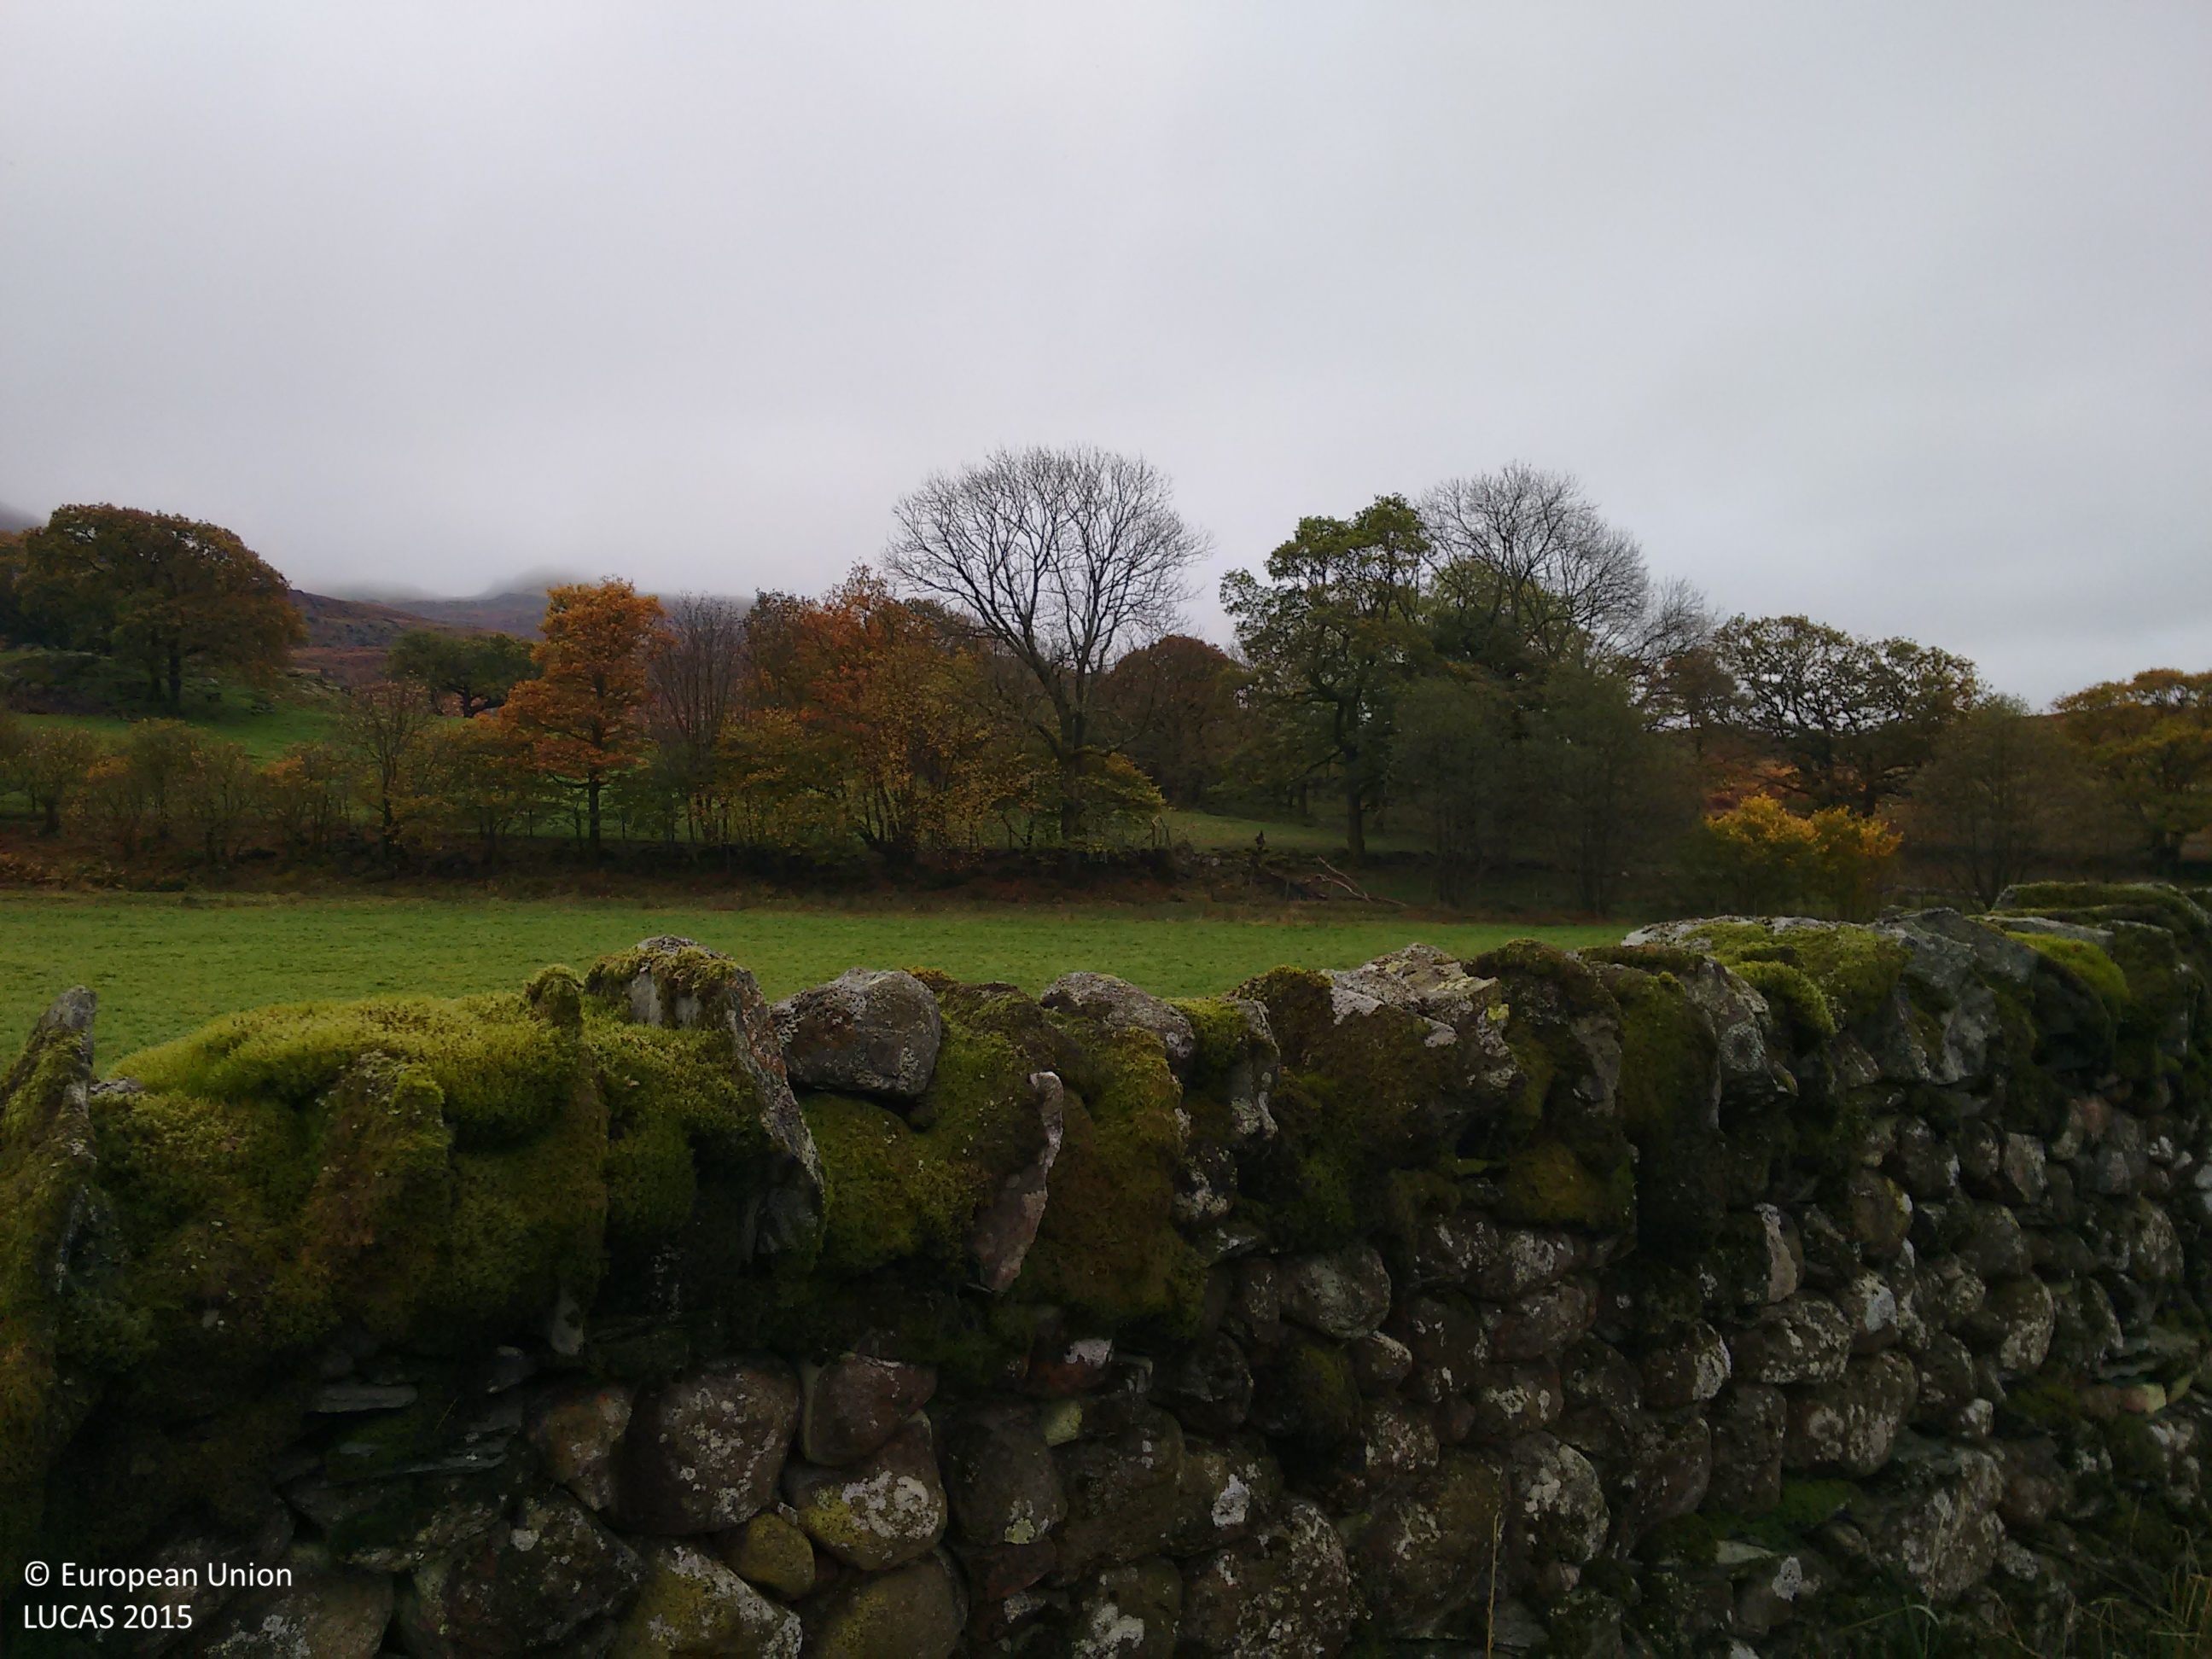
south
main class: Grassland
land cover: Grassland without tree/shrub cover
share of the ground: > 75 %
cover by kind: herbaceous plants 100 %
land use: Agriculture (excluding fallow land and kitchen gardens)
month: October
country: GB
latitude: 54.3526
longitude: -3.2008
